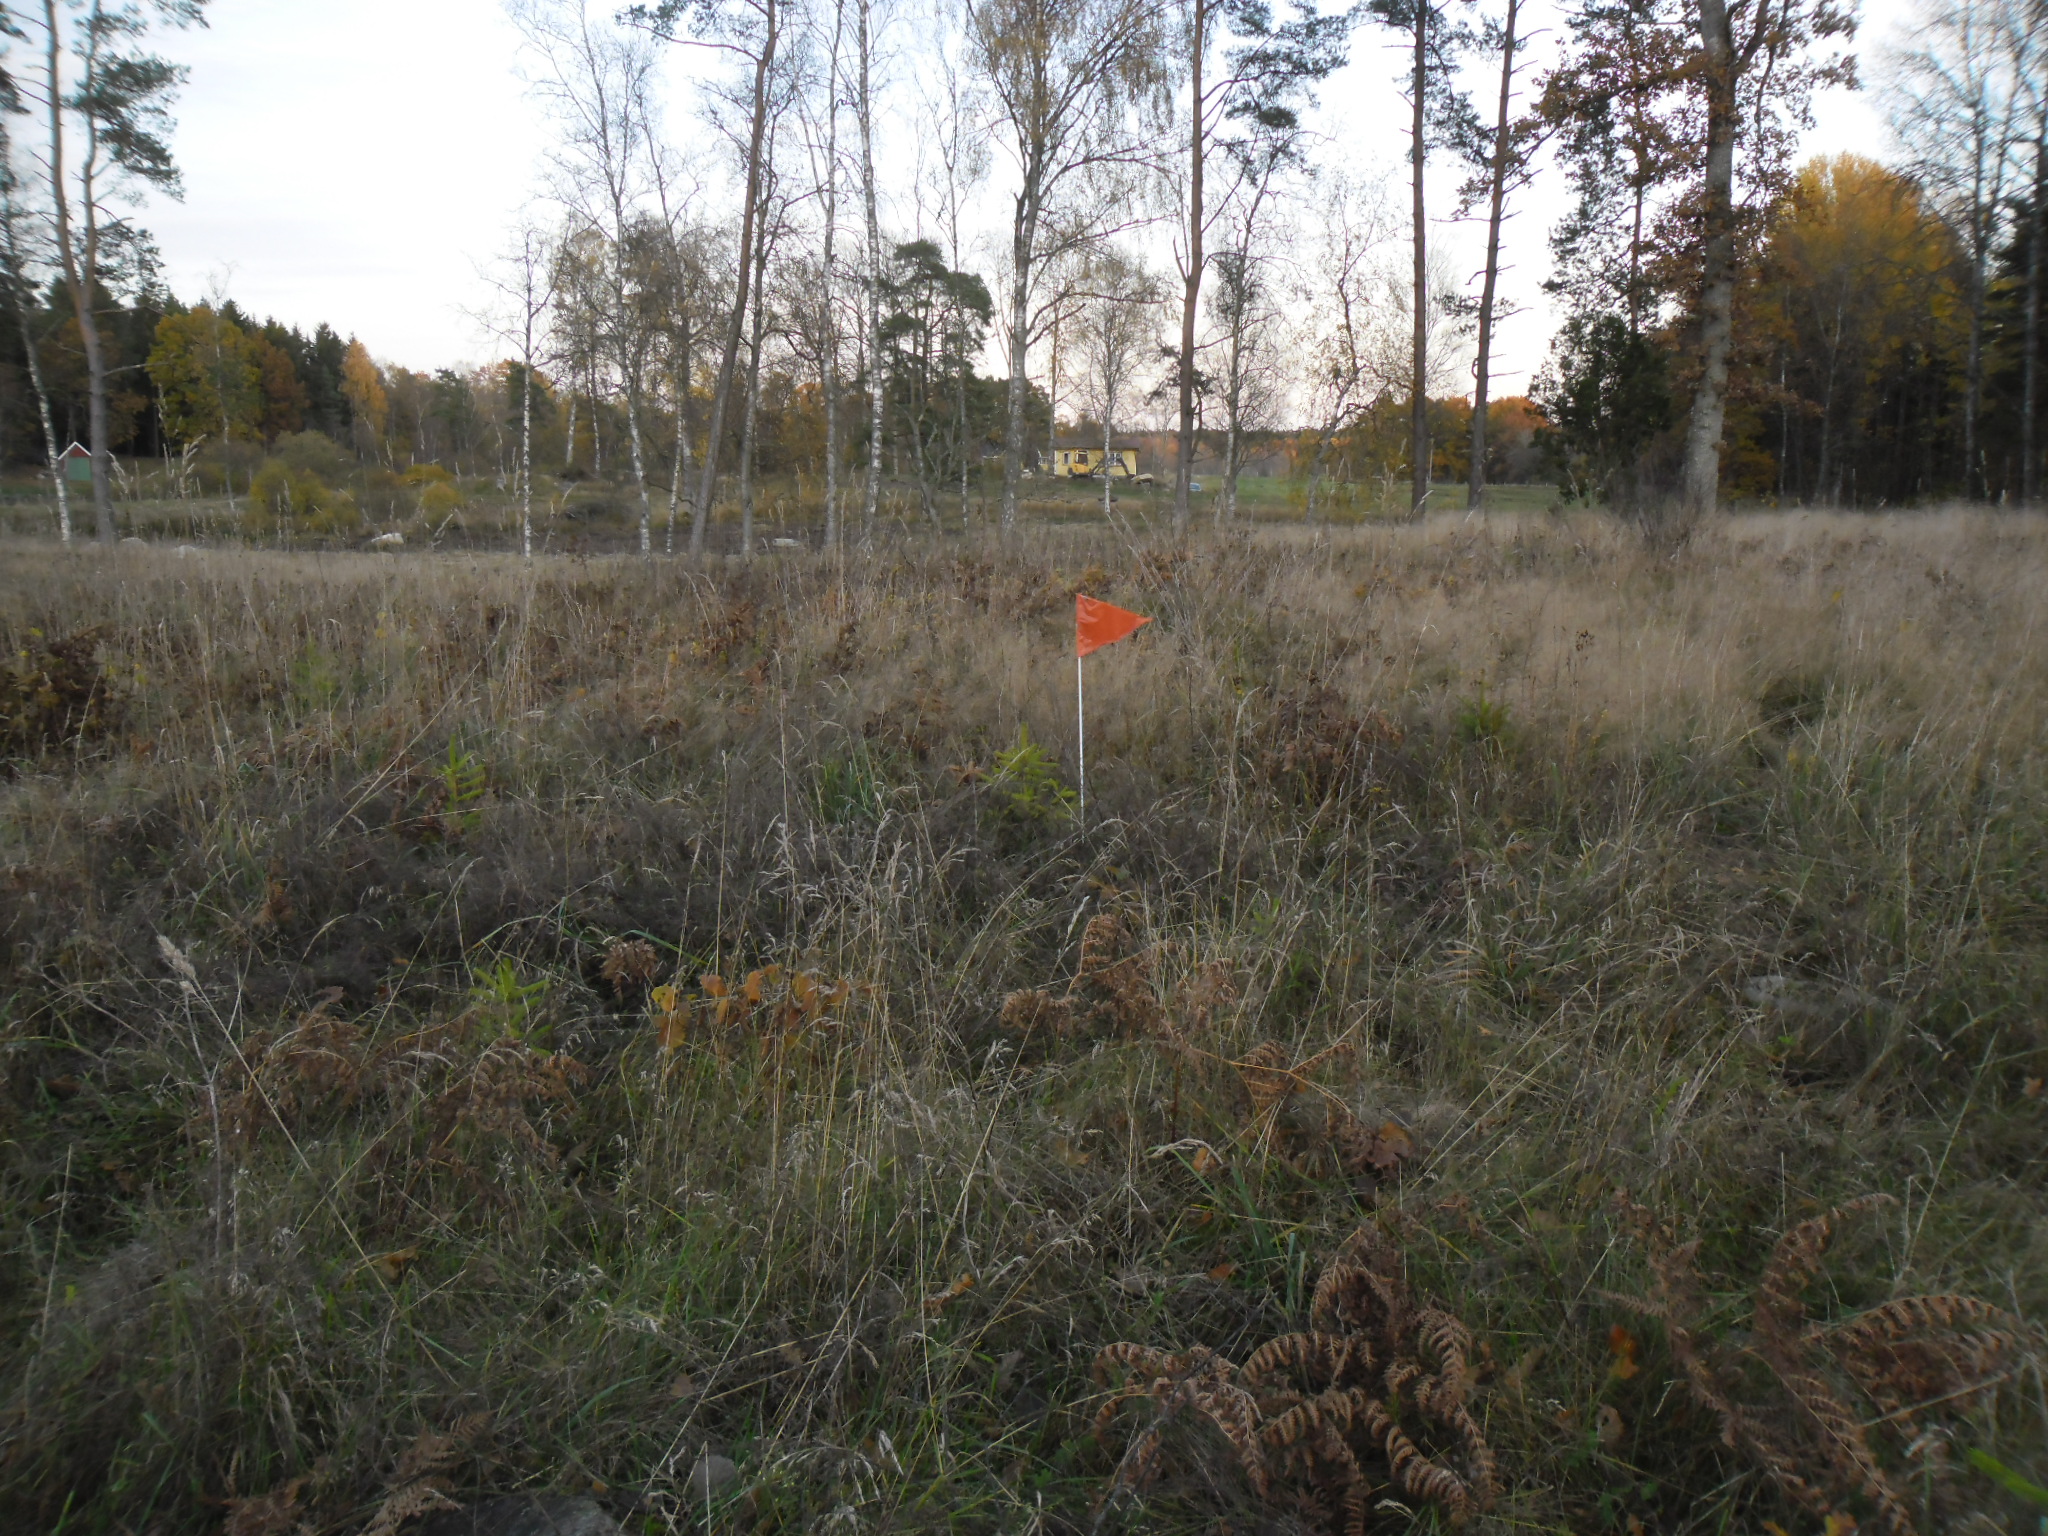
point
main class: Grassland
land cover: Grassland without tree/shrub cover
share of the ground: > 75 %
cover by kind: herbaceous plants 100 %
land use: Agriculture (excluding fallow land and kitchen gardens)
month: October
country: SE
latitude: 56.2229
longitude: 13.7552
